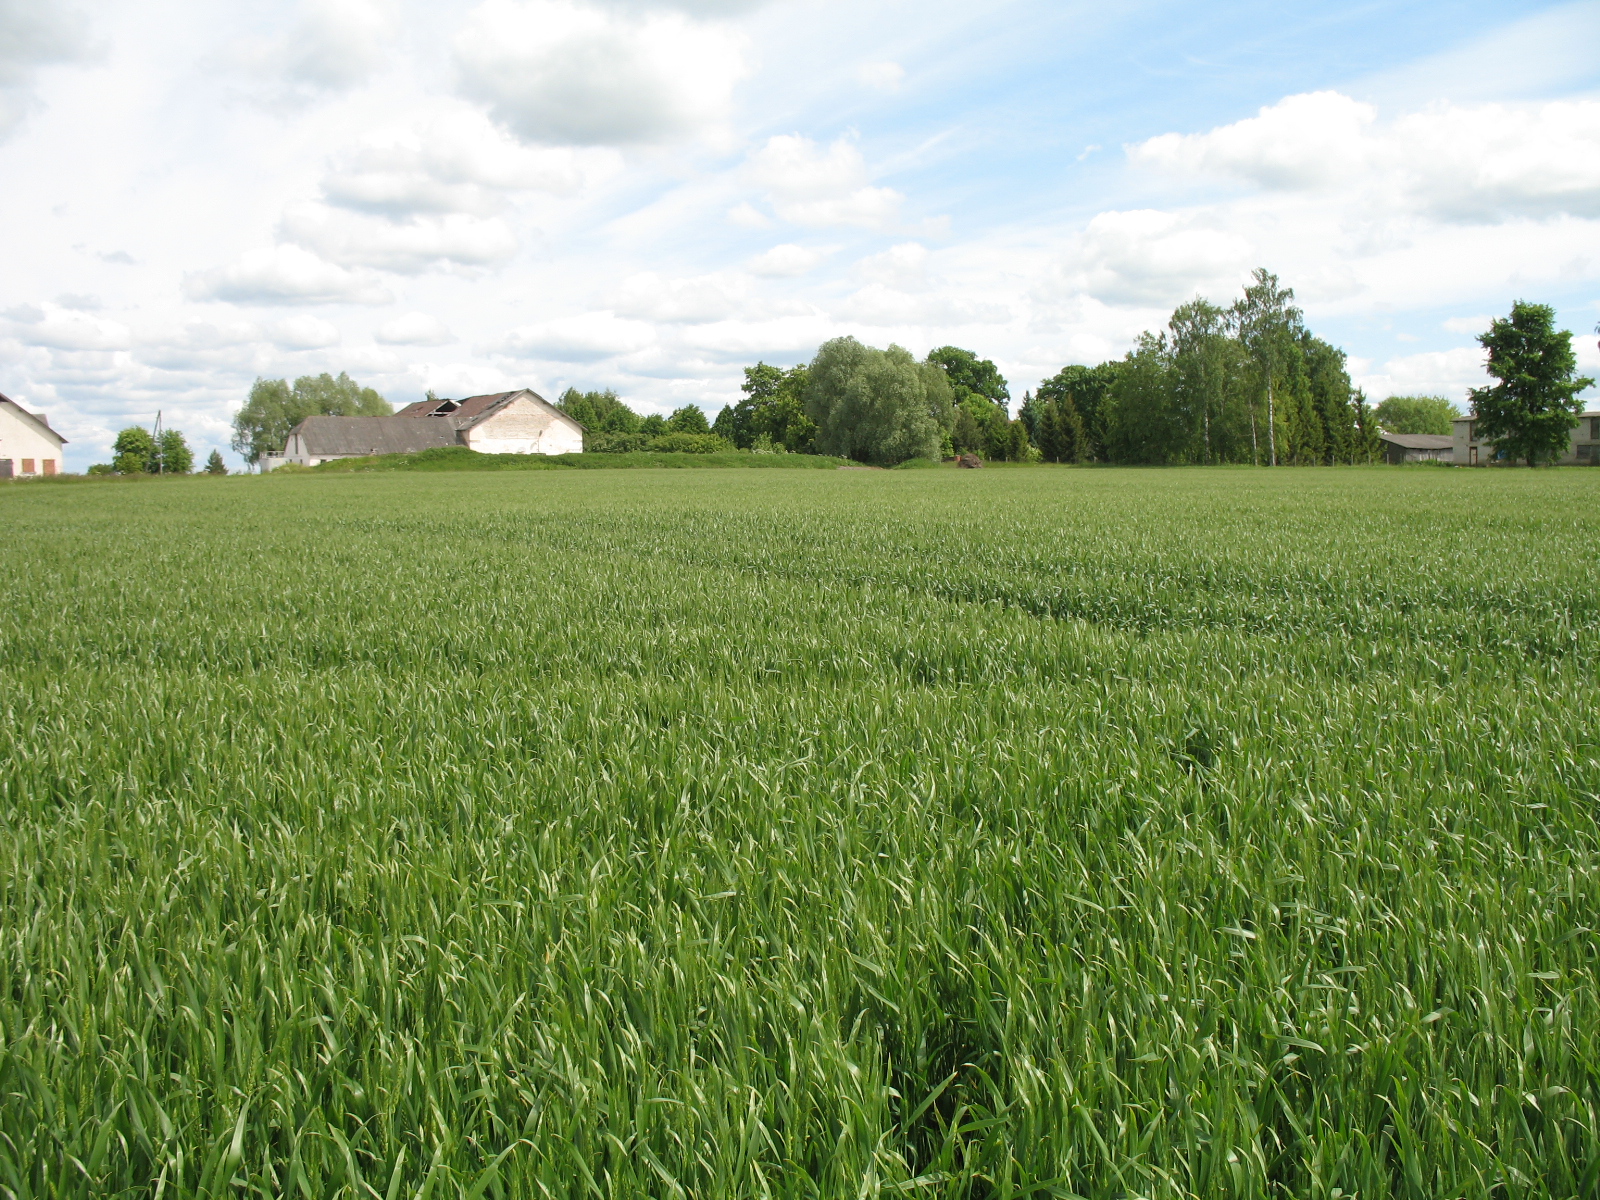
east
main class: Cropland
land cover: Barley
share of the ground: > 75 %
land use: Agriculture (excluding fallow land and kitchen gardens)
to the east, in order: Barley; Spontaneously vegetated surfaces; Ditches and canals; Spontaneously vegetated surfaces; Inland fresh water bodies; Spontaneously vegetated surfaces; Artificial constructions in urban areas
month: June
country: LV
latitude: 56.6076
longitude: 23.4489
